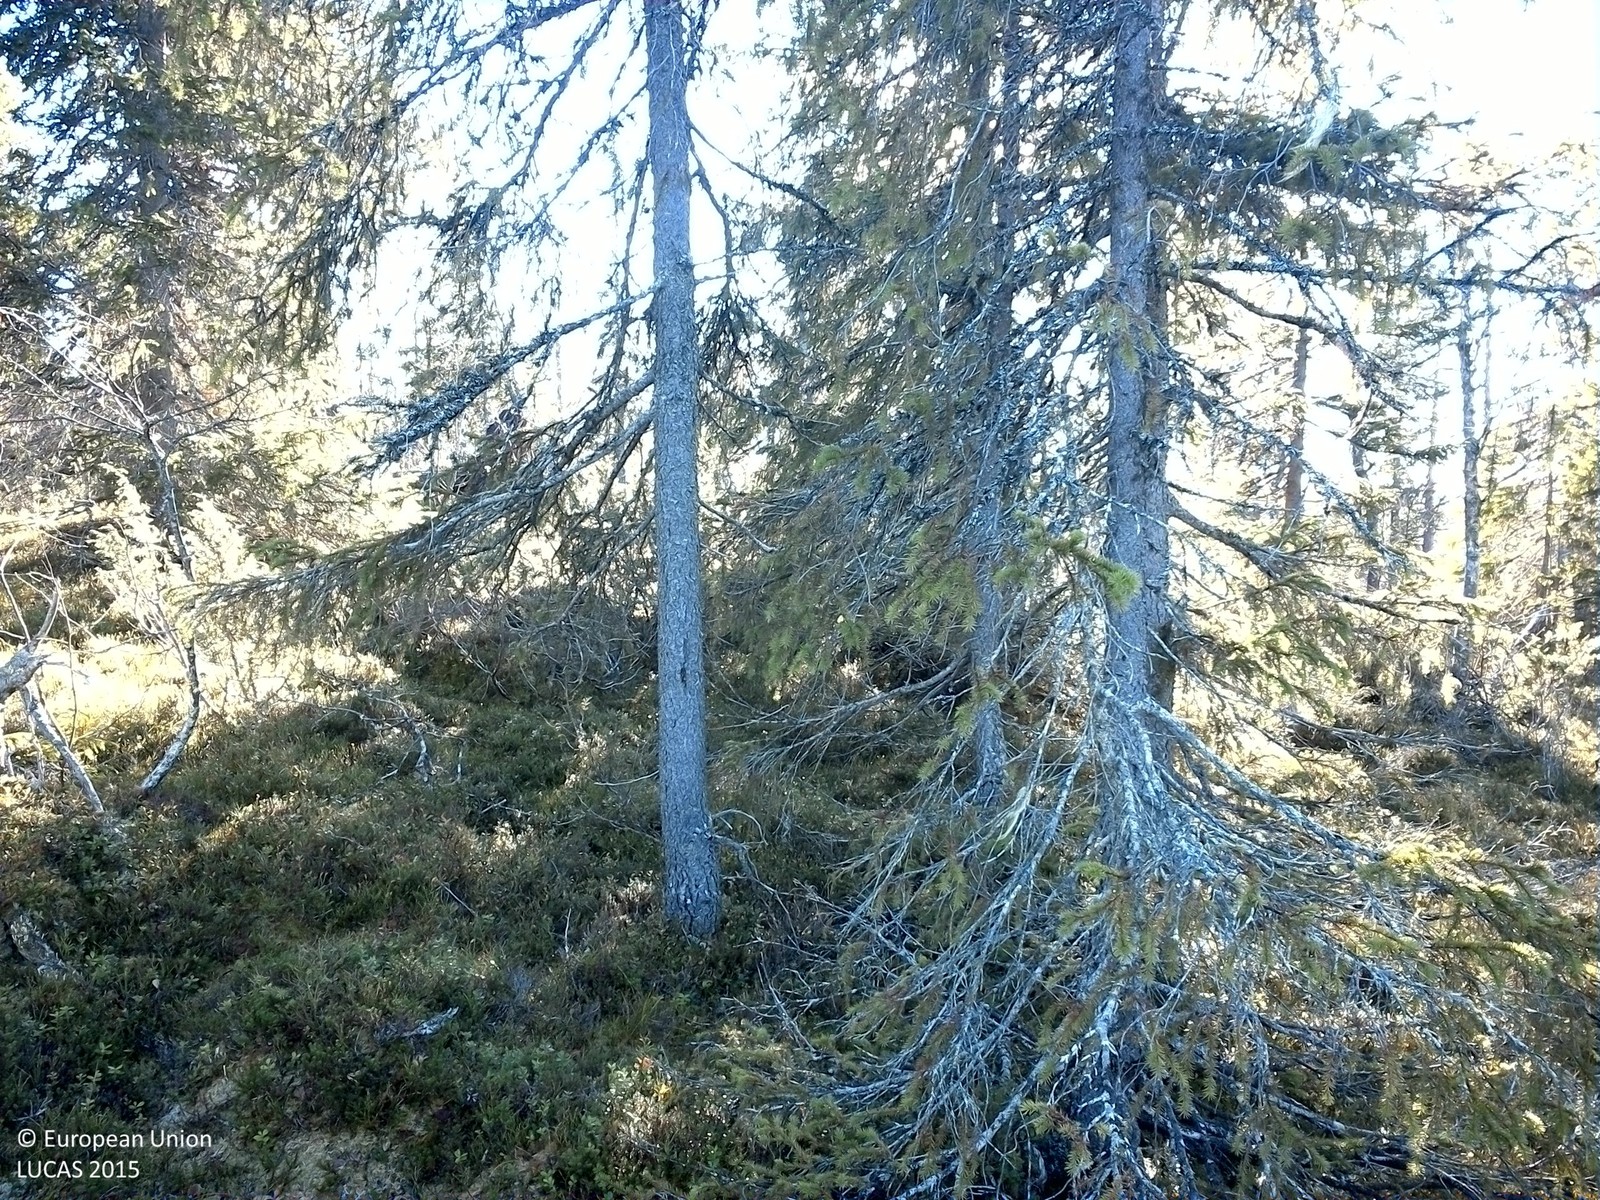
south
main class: Woodland
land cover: Spruce dominated mixed woodland
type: boreal forest
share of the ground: 50 - 75 %
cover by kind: coniferous forest trees 35 %, shrubs 30 %, lichens and mosses 20 %, broadleaved forest trees 15 %
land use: Forestry
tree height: > 5 m
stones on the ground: < 10 %
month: October
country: SE
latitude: 64.6882
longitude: 14.7722
